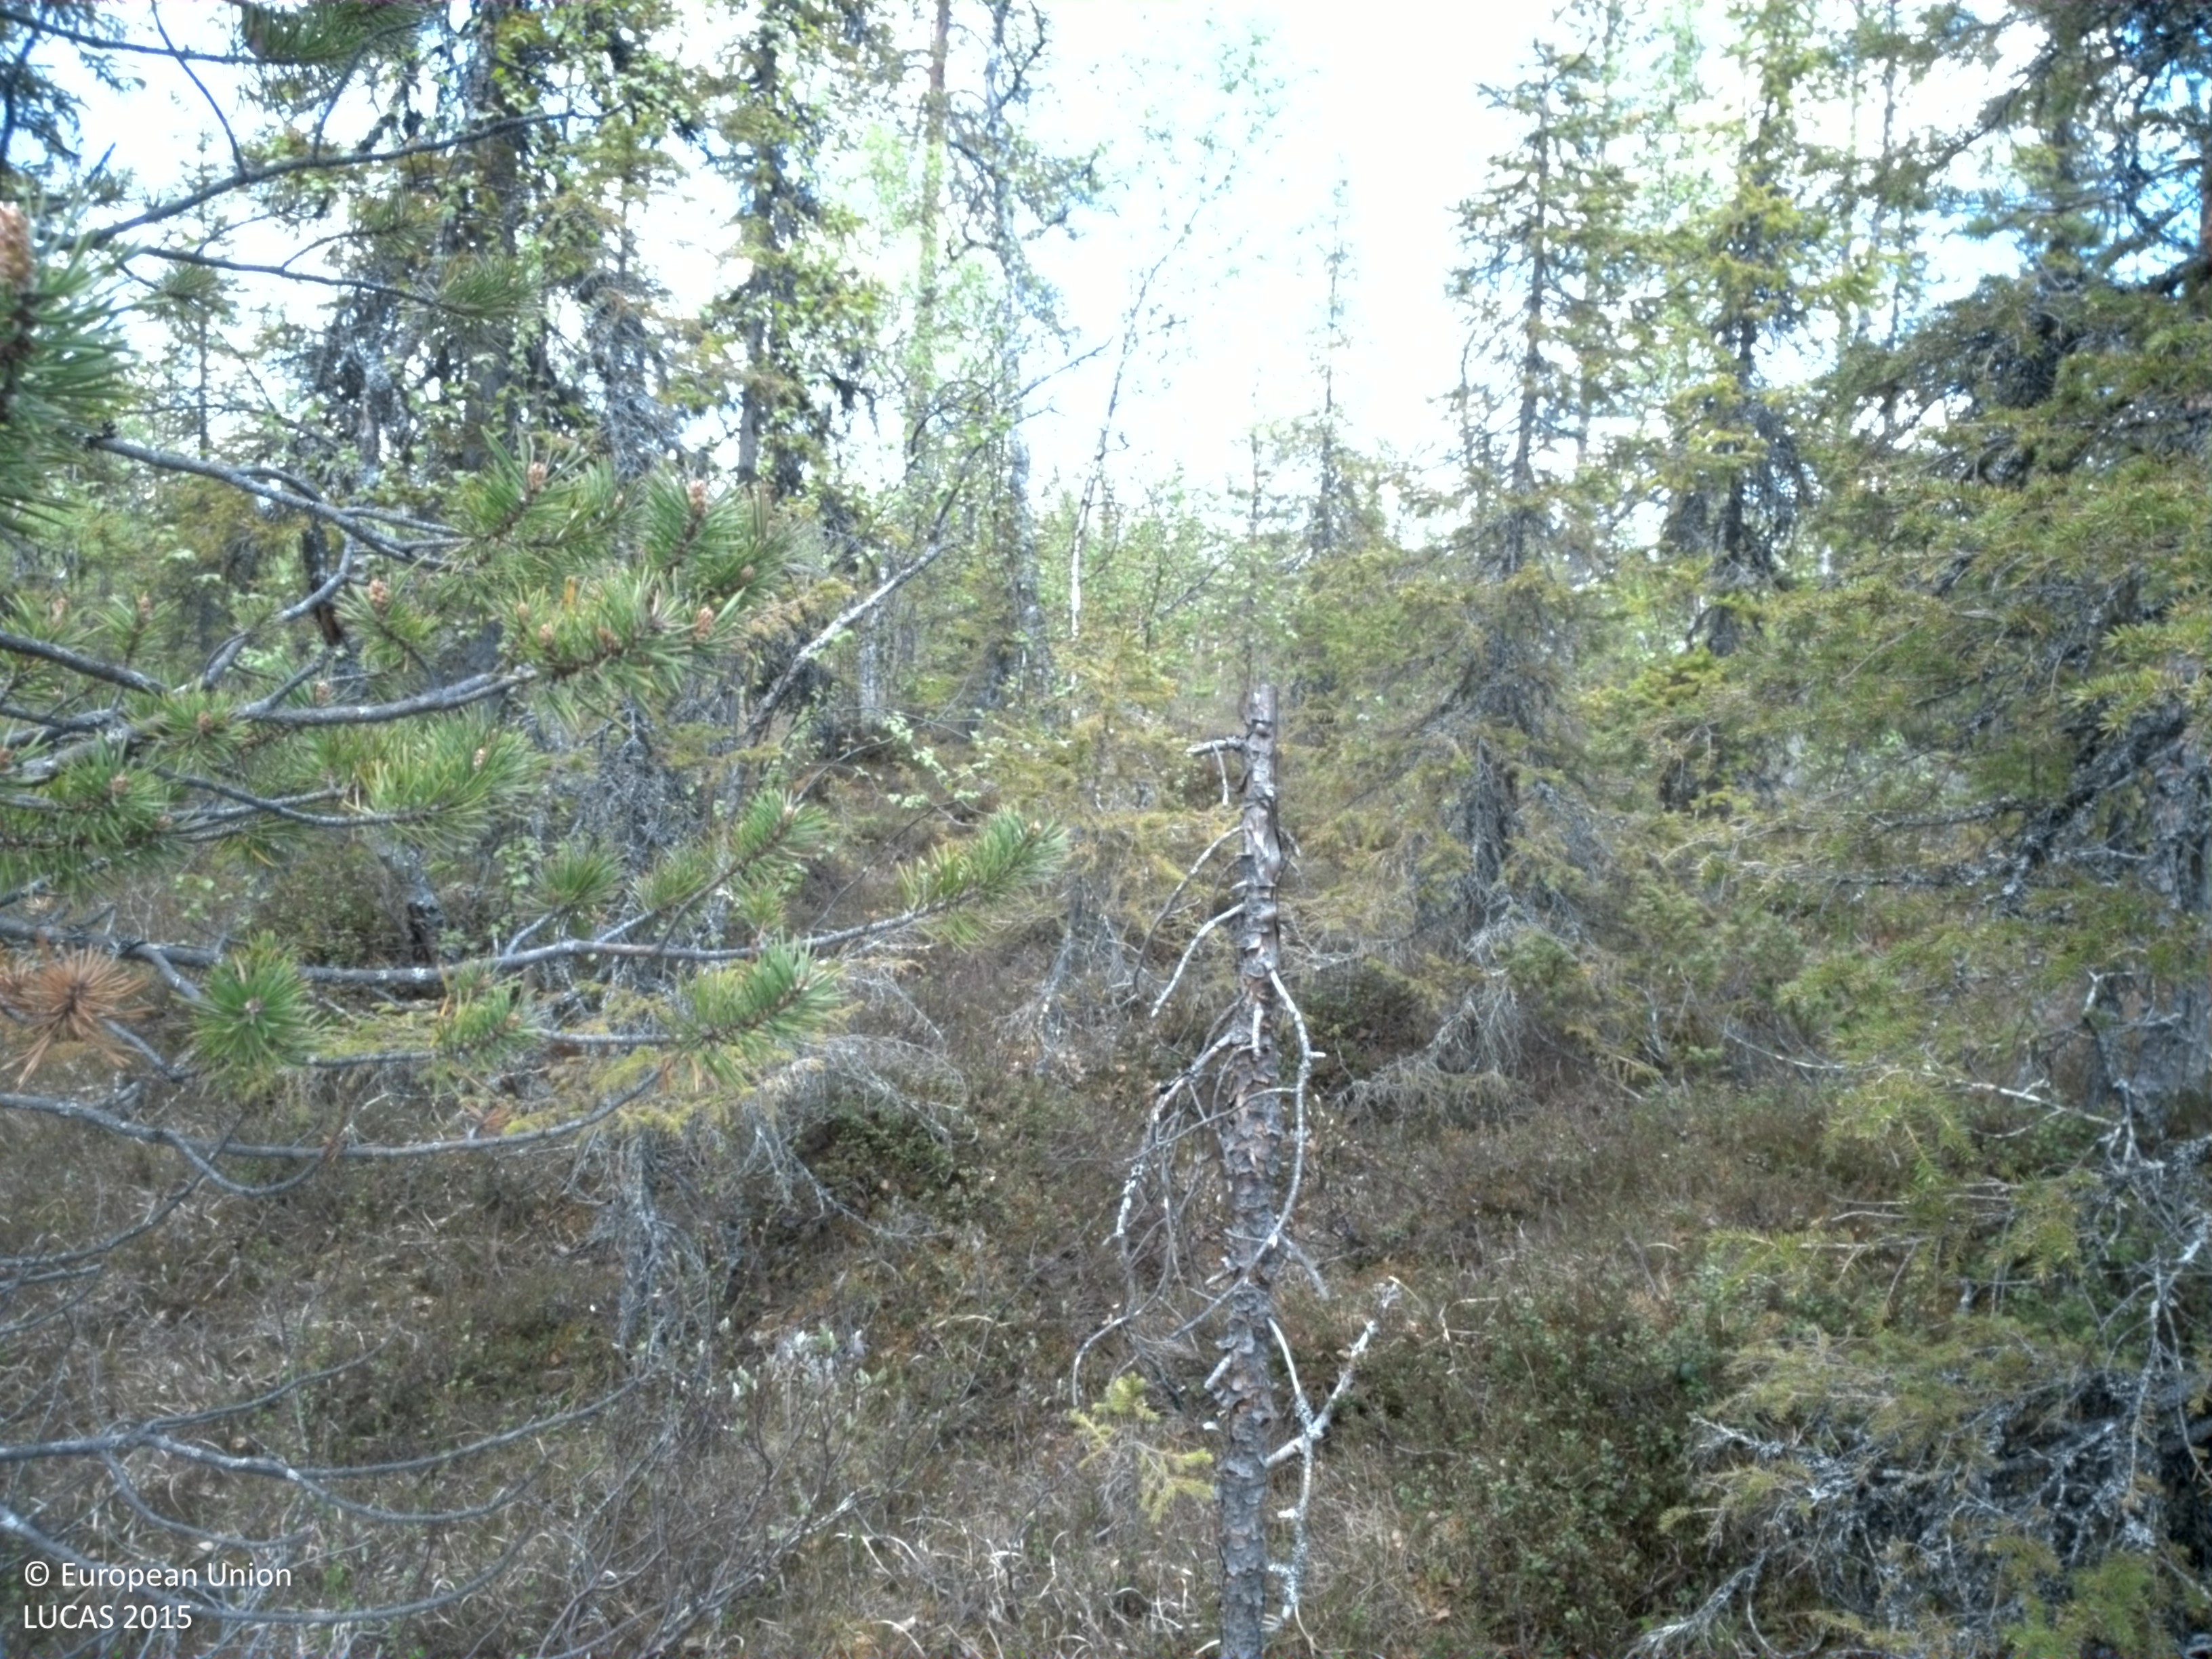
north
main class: Woodland
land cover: Pine dominated mixed woodland
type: boreal forest
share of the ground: 25 - 50 %
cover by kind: shrubs 55 %, coniferous forest trees 25 %, broadleaved forest trees 10 %, herbaceous plants 10 %
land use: Forestry
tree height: > 5 m
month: June
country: SE
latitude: 66.1028
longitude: 19.4469
